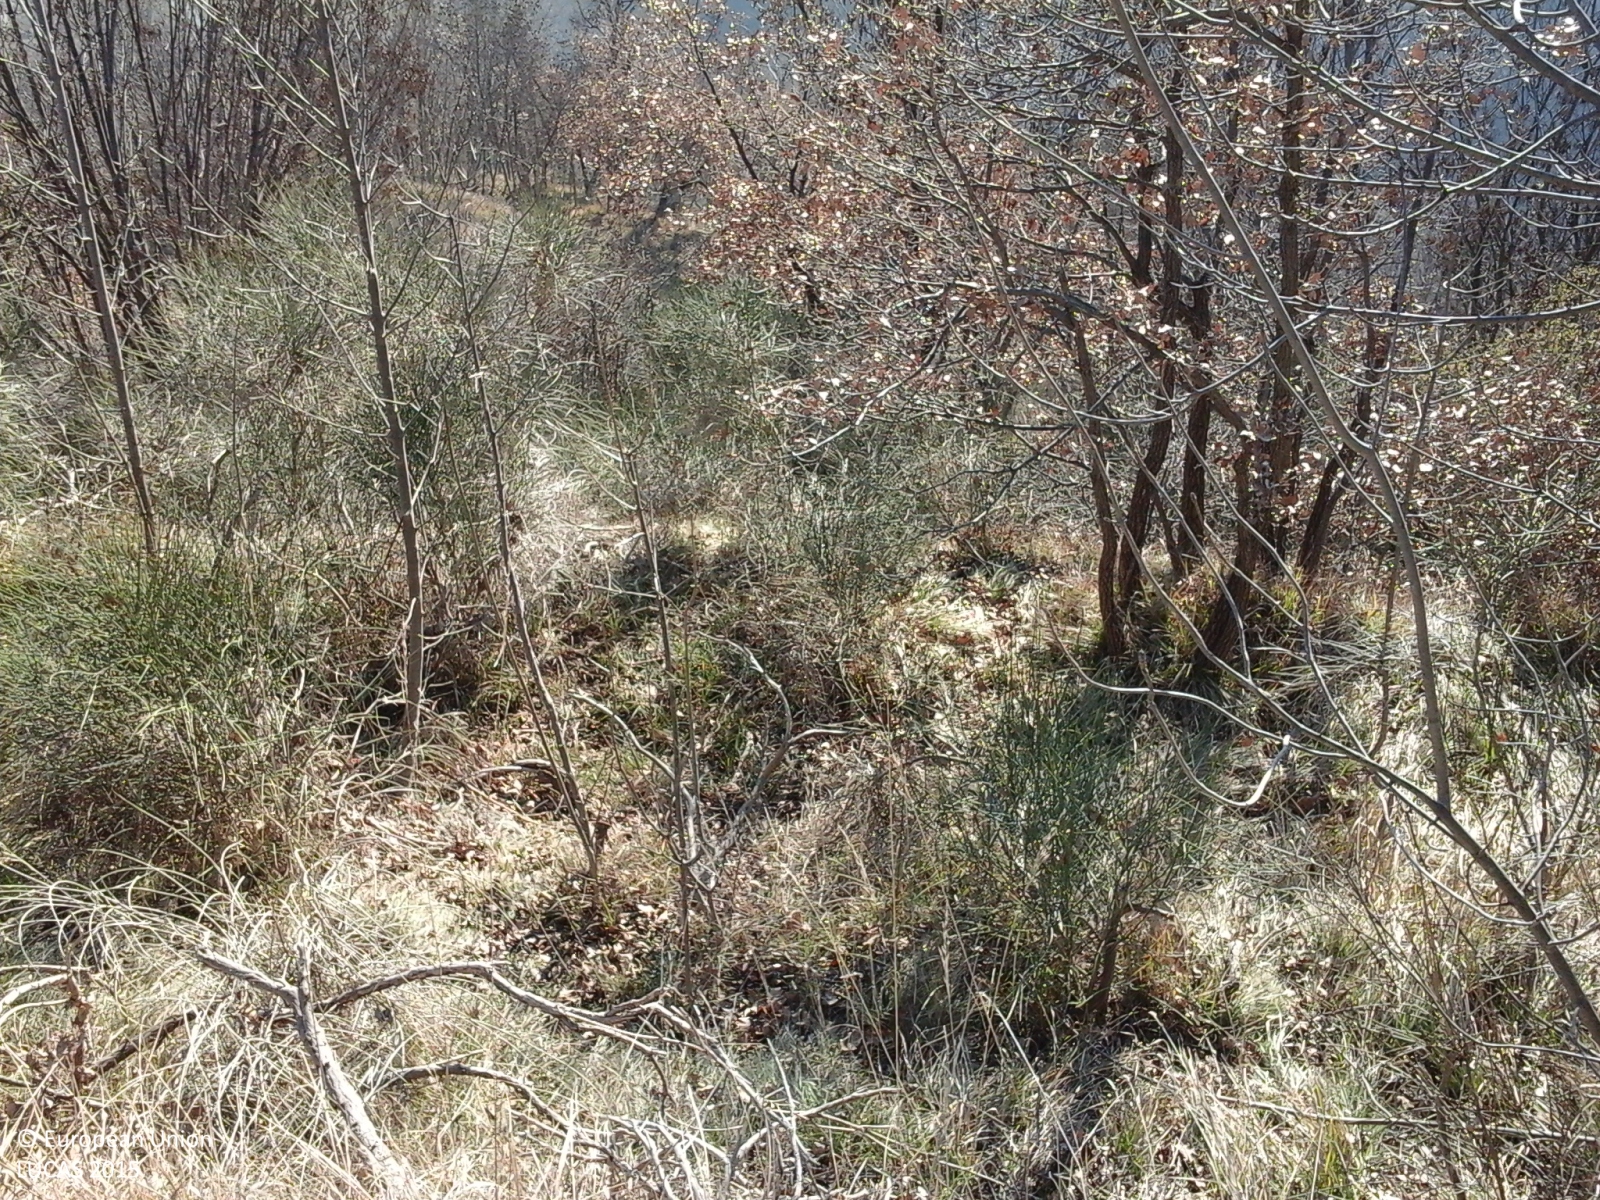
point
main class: Woodland
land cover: Broadleaved woodland
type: thermophilous deciduous forest
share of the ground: > 75 %
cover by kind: broadleaved forest trees 80 %, coniferous forest trees 20 %
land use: Forestry
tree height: > 5 m
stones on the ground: 10 - 25 %
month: January
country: IT
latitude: 44.4622
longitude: 8.2567
